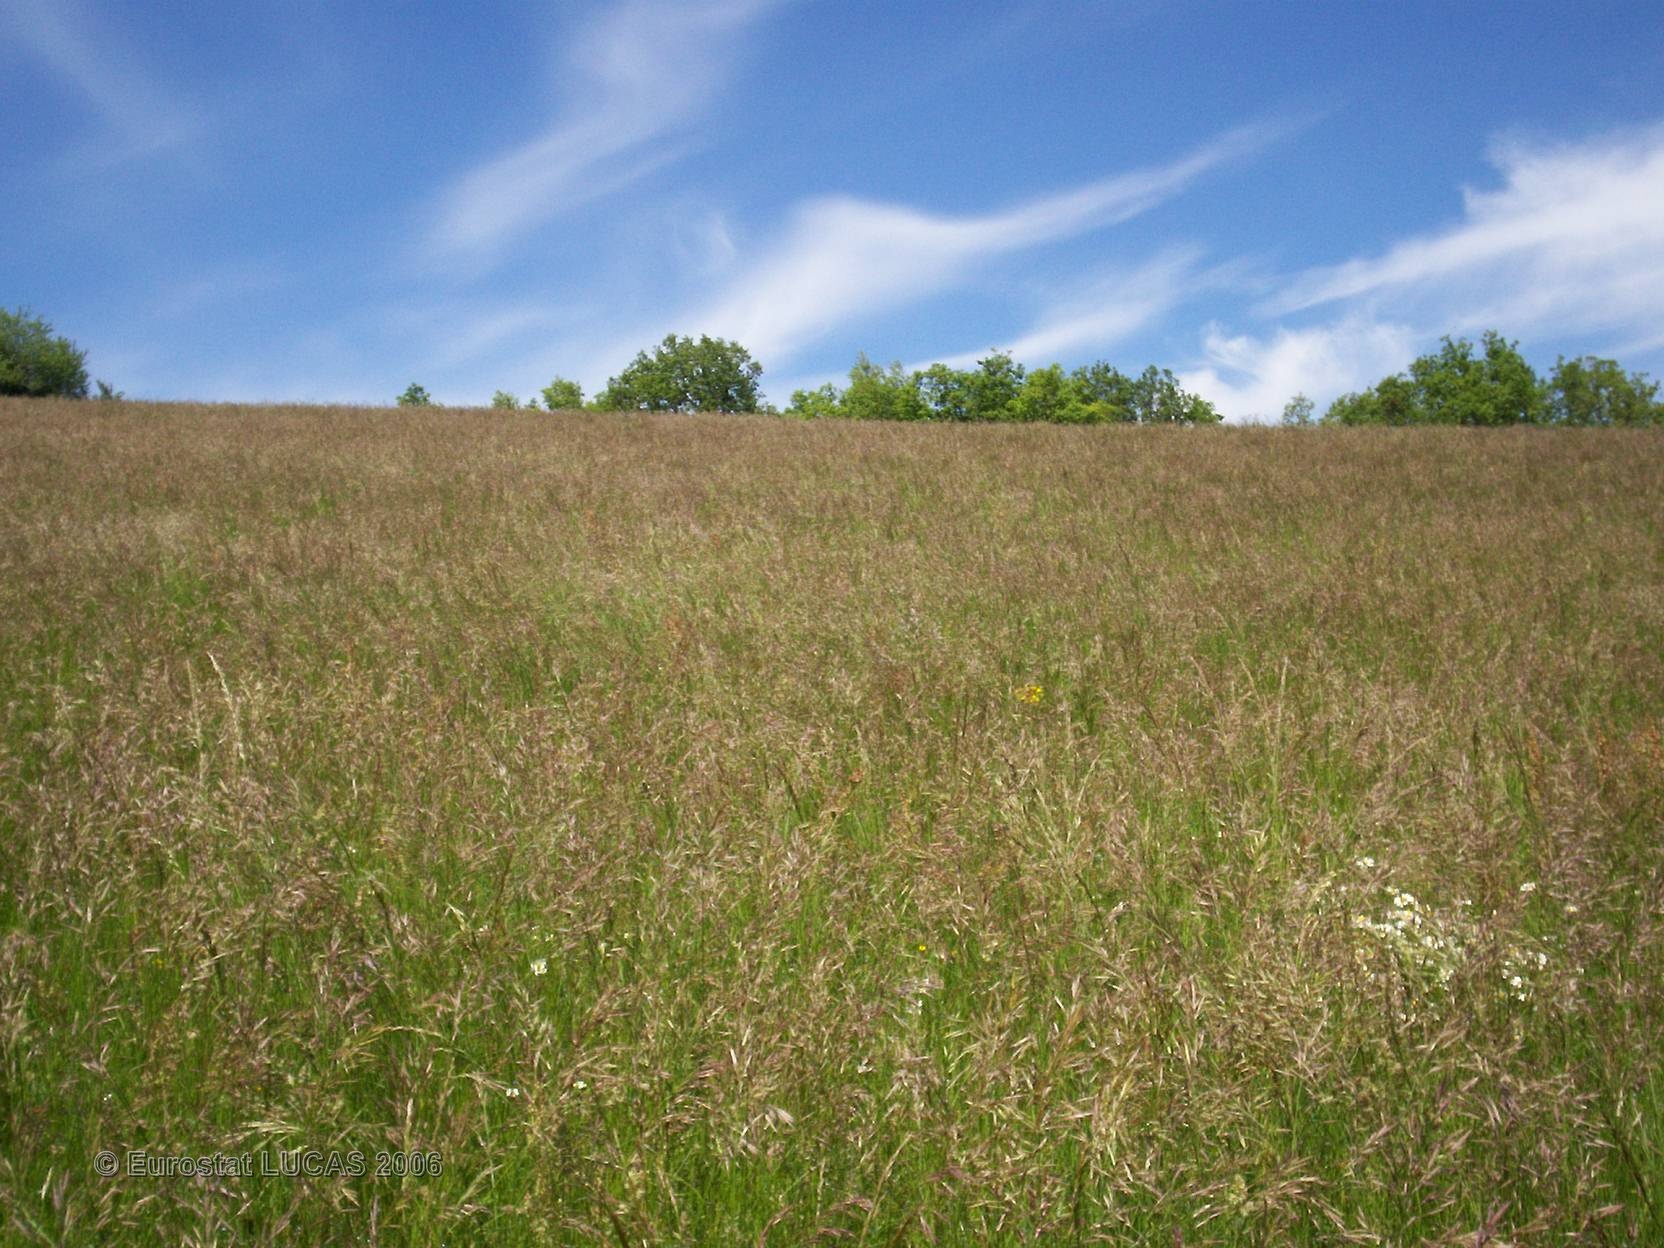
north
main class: Grassland
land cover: Grassland without tree/shrub cover
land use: Agriculture (excluding fallow land and kitchen gardens)
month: May
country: FR
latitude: 44.0934
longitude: 1.9710
